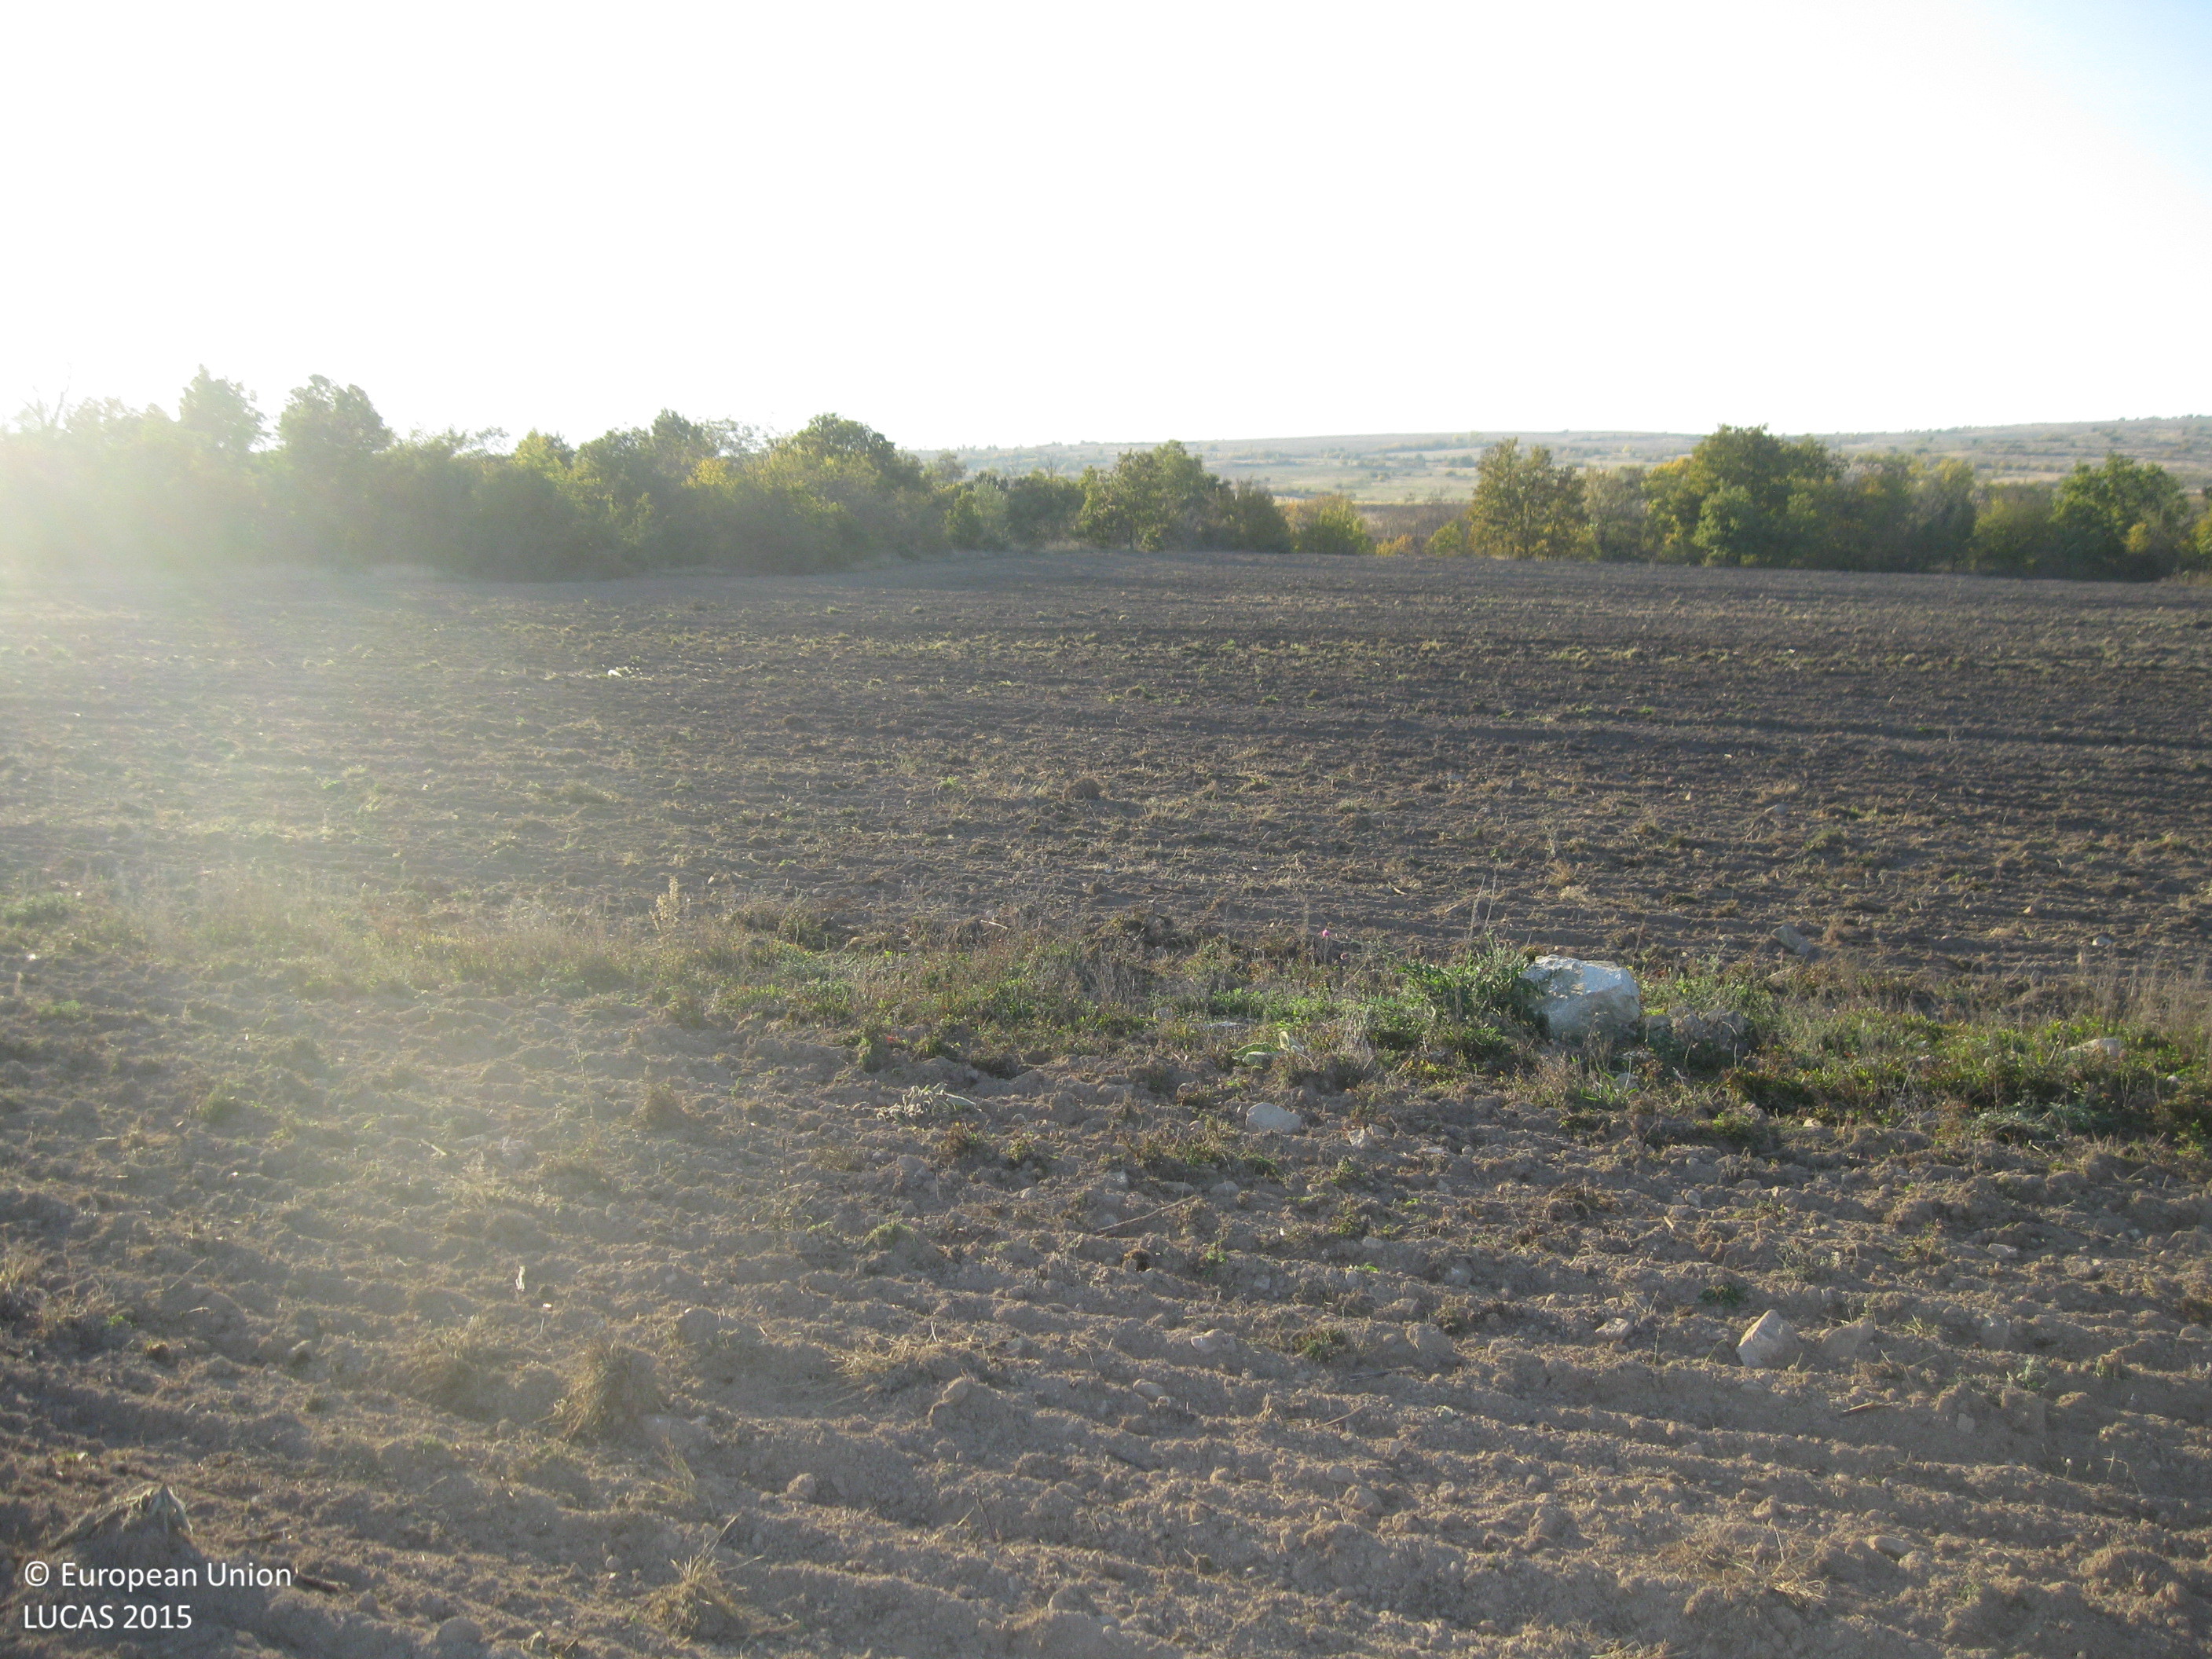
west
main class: Cropland
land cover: Sunflower
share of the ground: < 10 %
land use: Agriculture (excluding fallow land and kitchen gardens)
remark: Harvested field
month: November
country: BG
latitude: 42.3210
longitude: 24.2291
